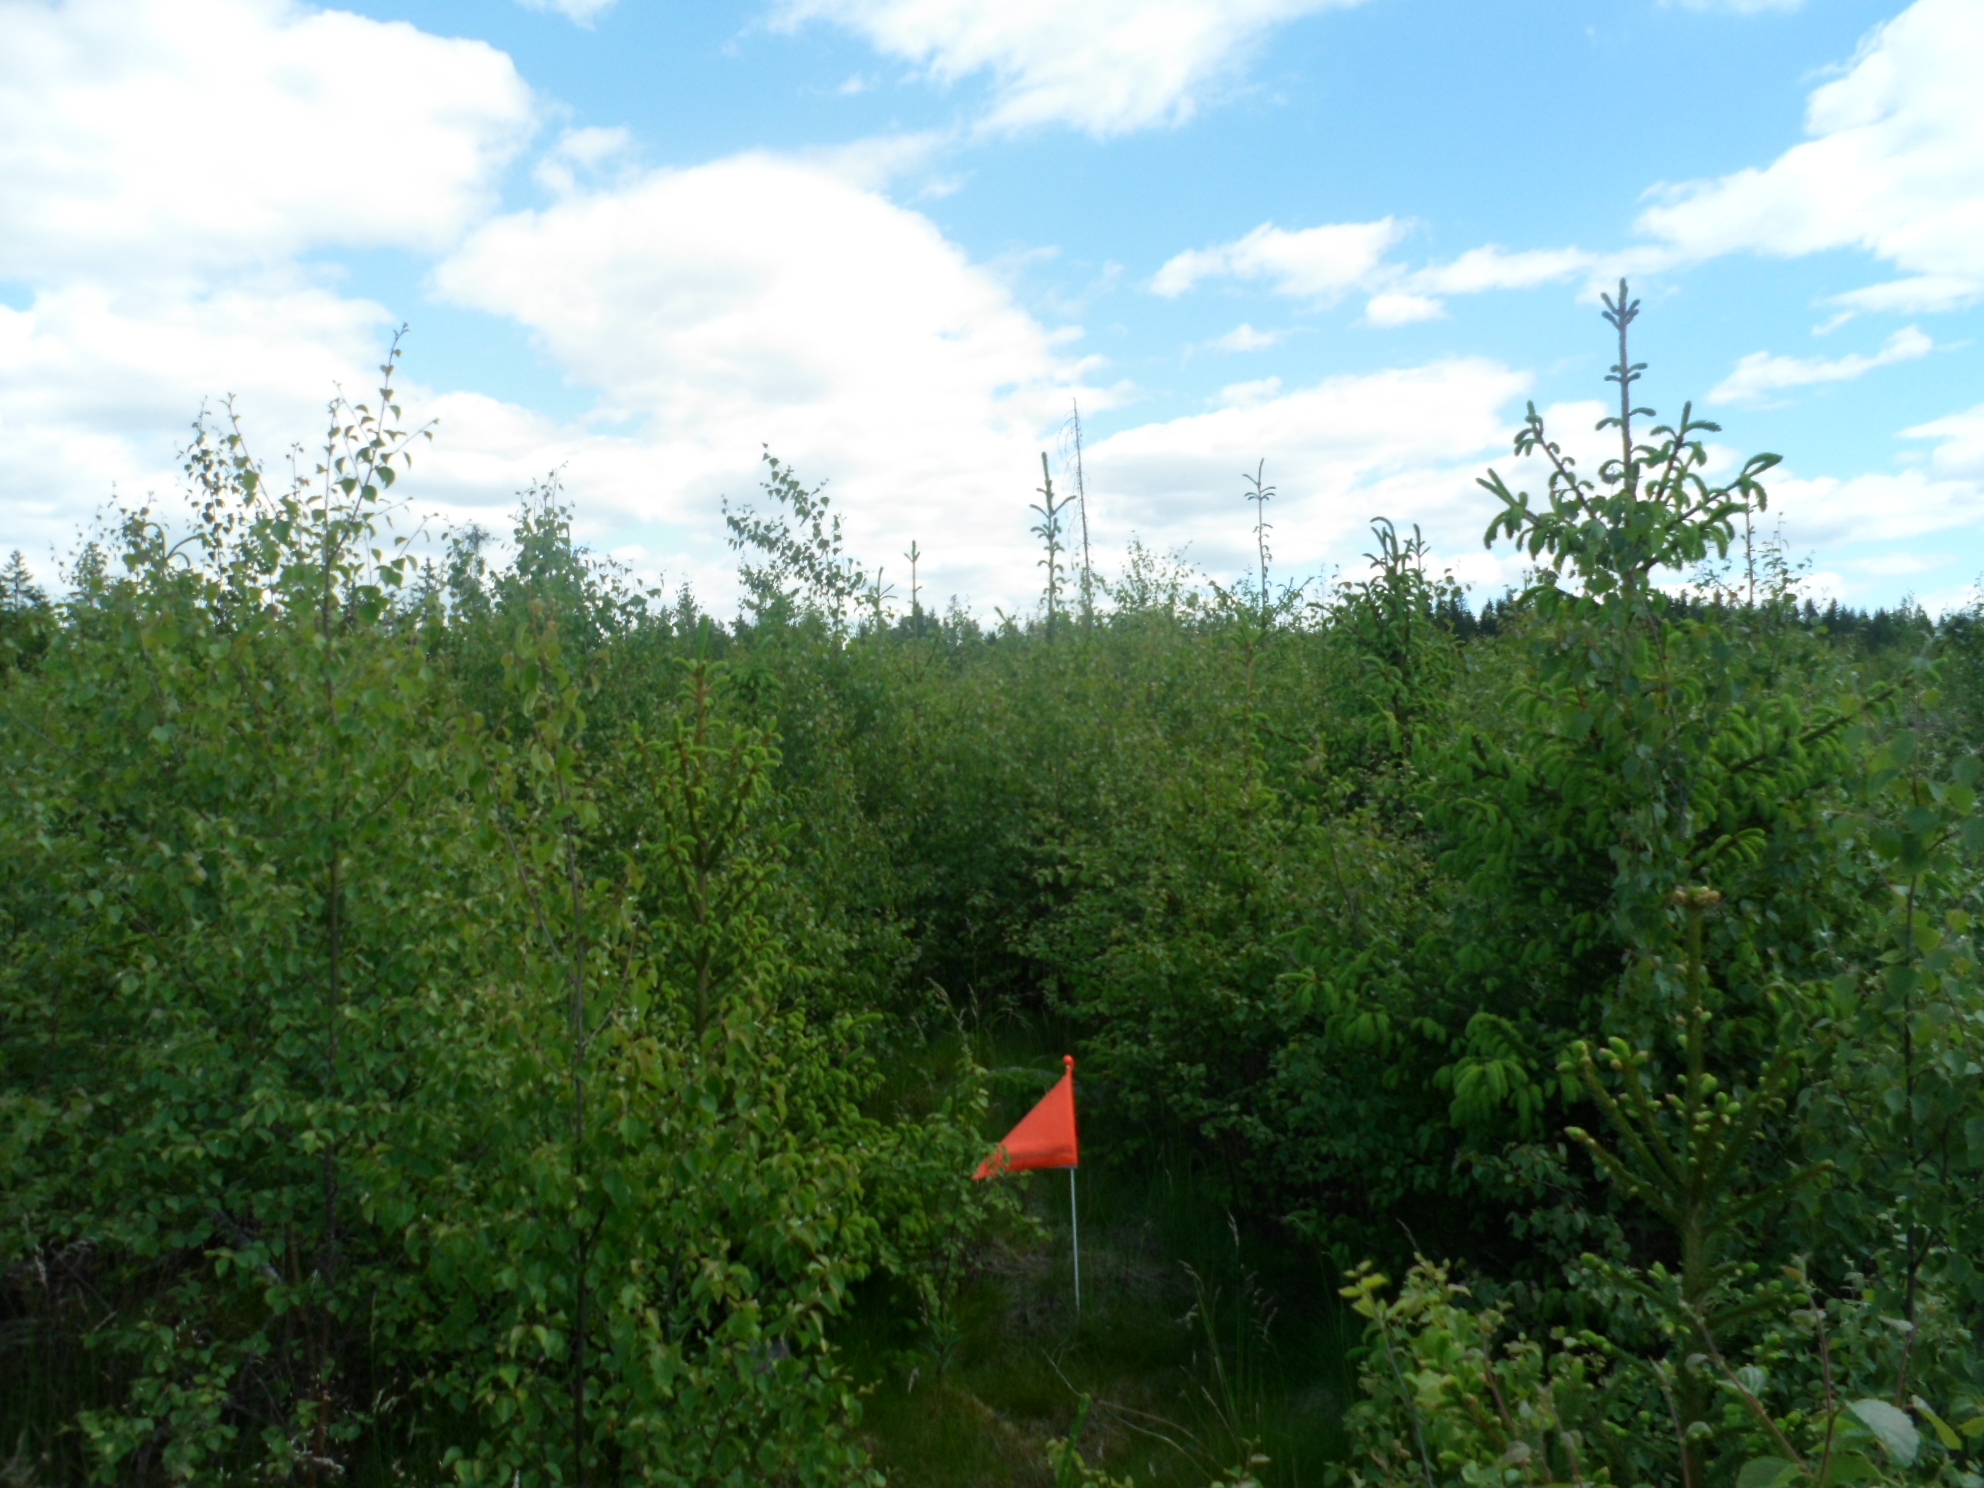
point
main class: Woodland
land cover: Spruce dominated mixed woodland
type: boreal forest
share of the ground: > 75 %
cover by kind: broadleaved forest trees 45 %, coniferous forest trees 35 %, herbaceous plants 15 %, shrubs 5 %
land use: Forestry
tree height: < 5 m
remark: Clear cut
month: July
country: SE
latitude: 57.4267
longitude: 14.4090
